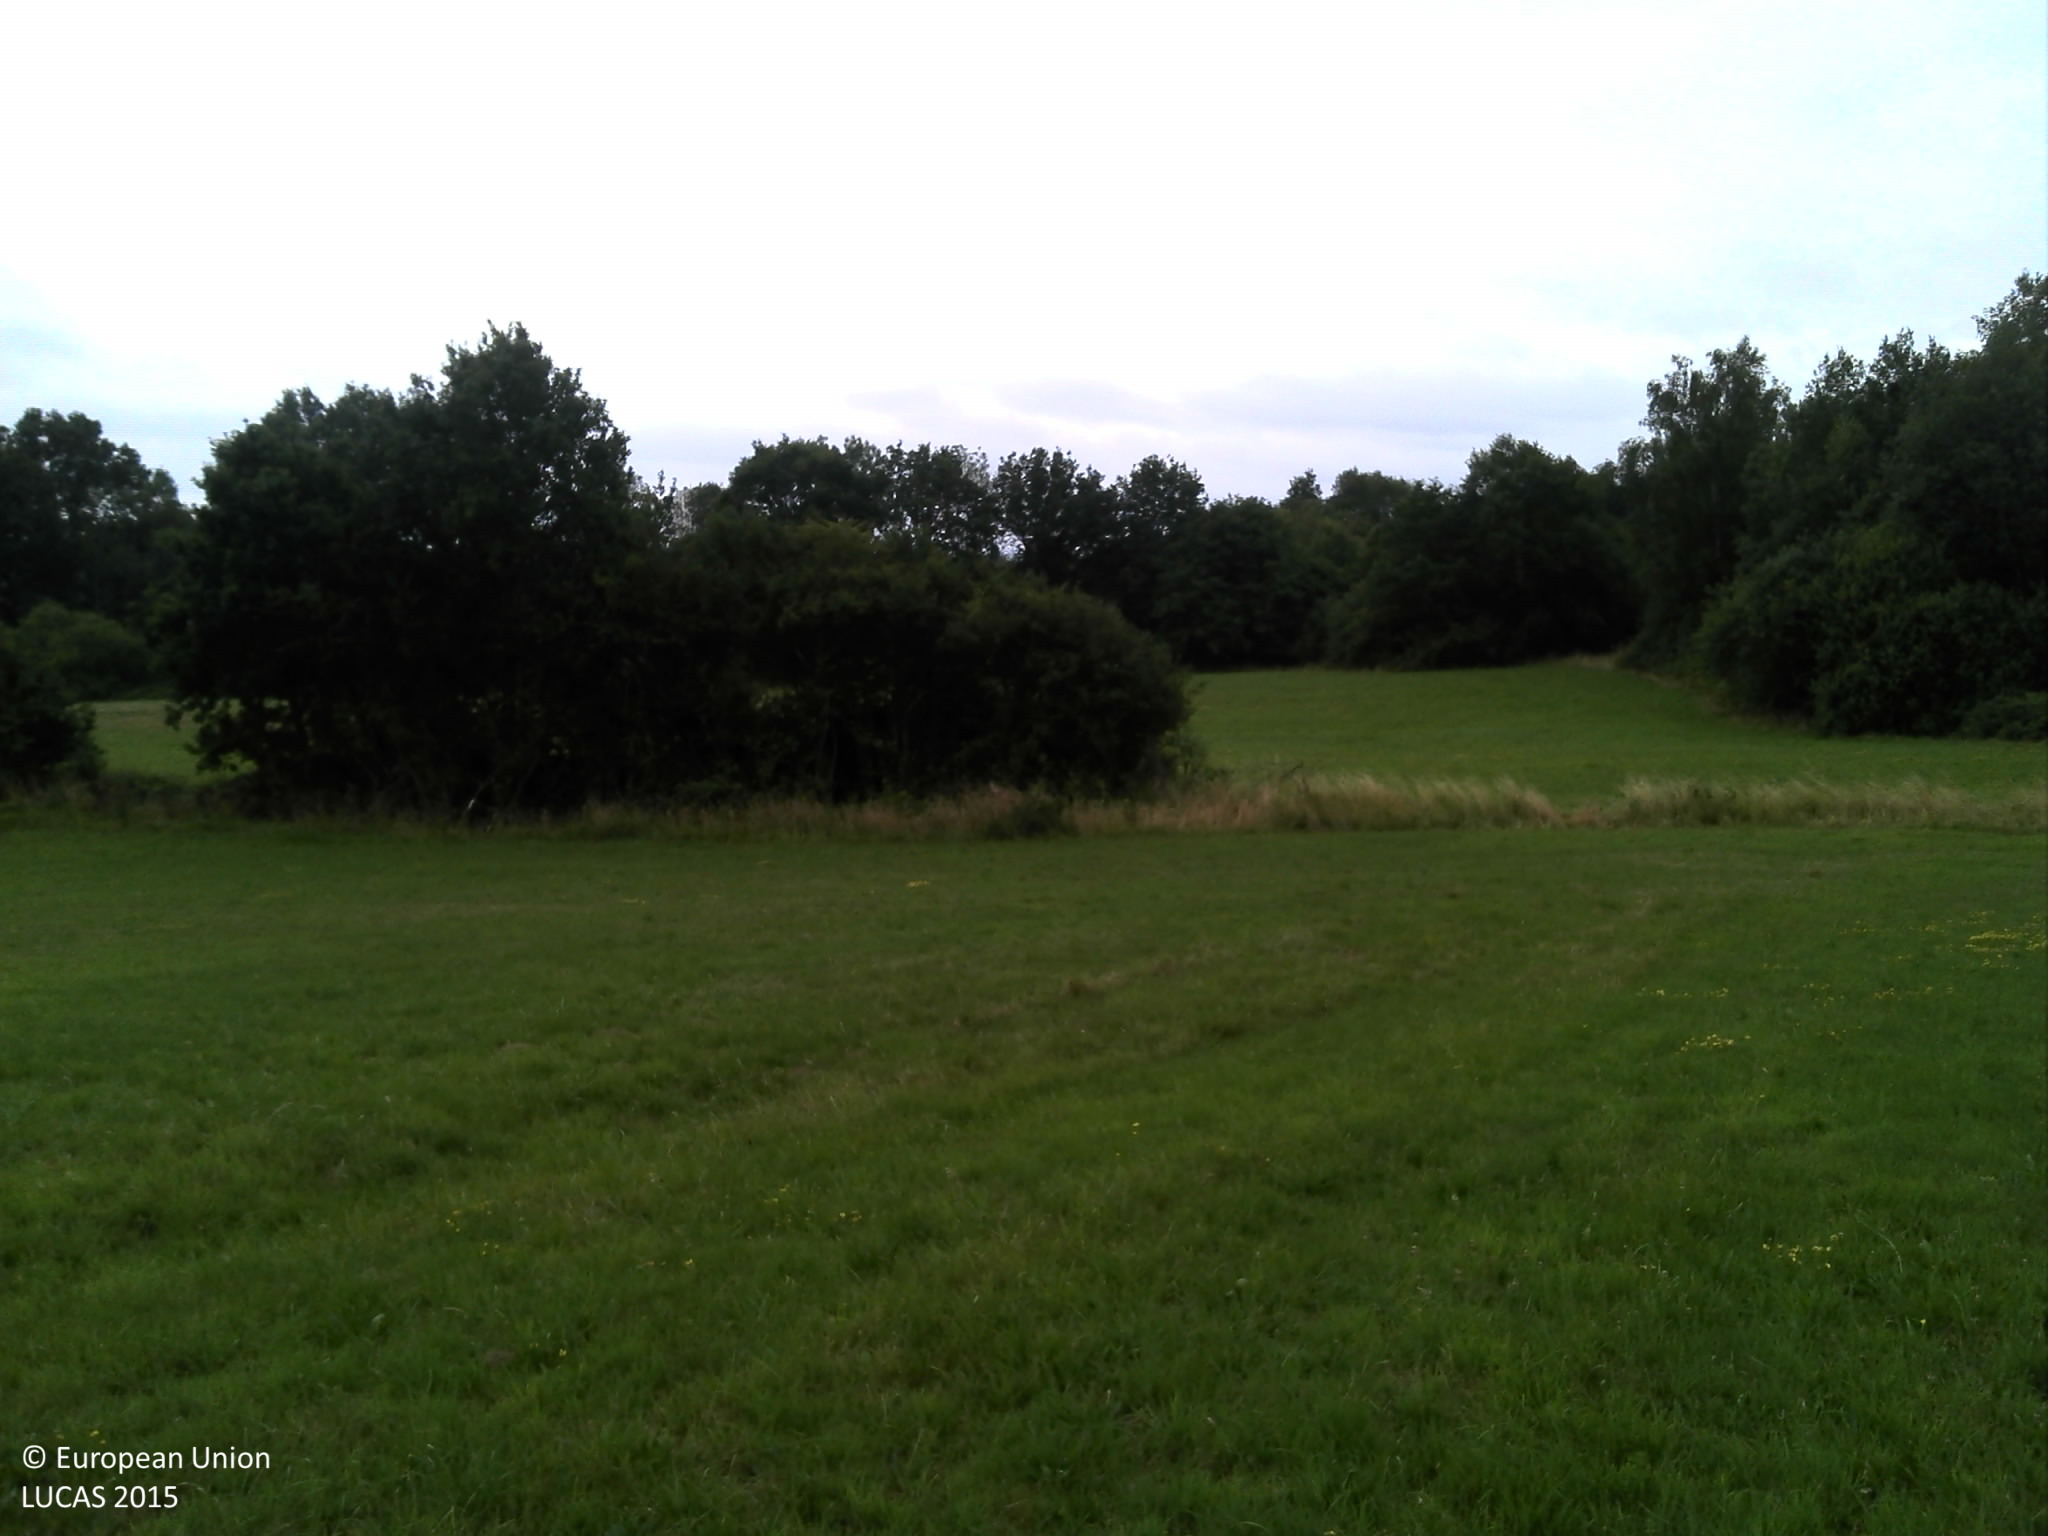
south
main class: Grassland
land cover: Grassland without tree/shrub cover
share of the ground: > 75 %
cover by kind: herbaceous plants 100 %
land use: Agriculture (excluding fallow land and kitchen gardens)
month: July
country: FR
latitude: 49.7909
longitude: 4.7043
